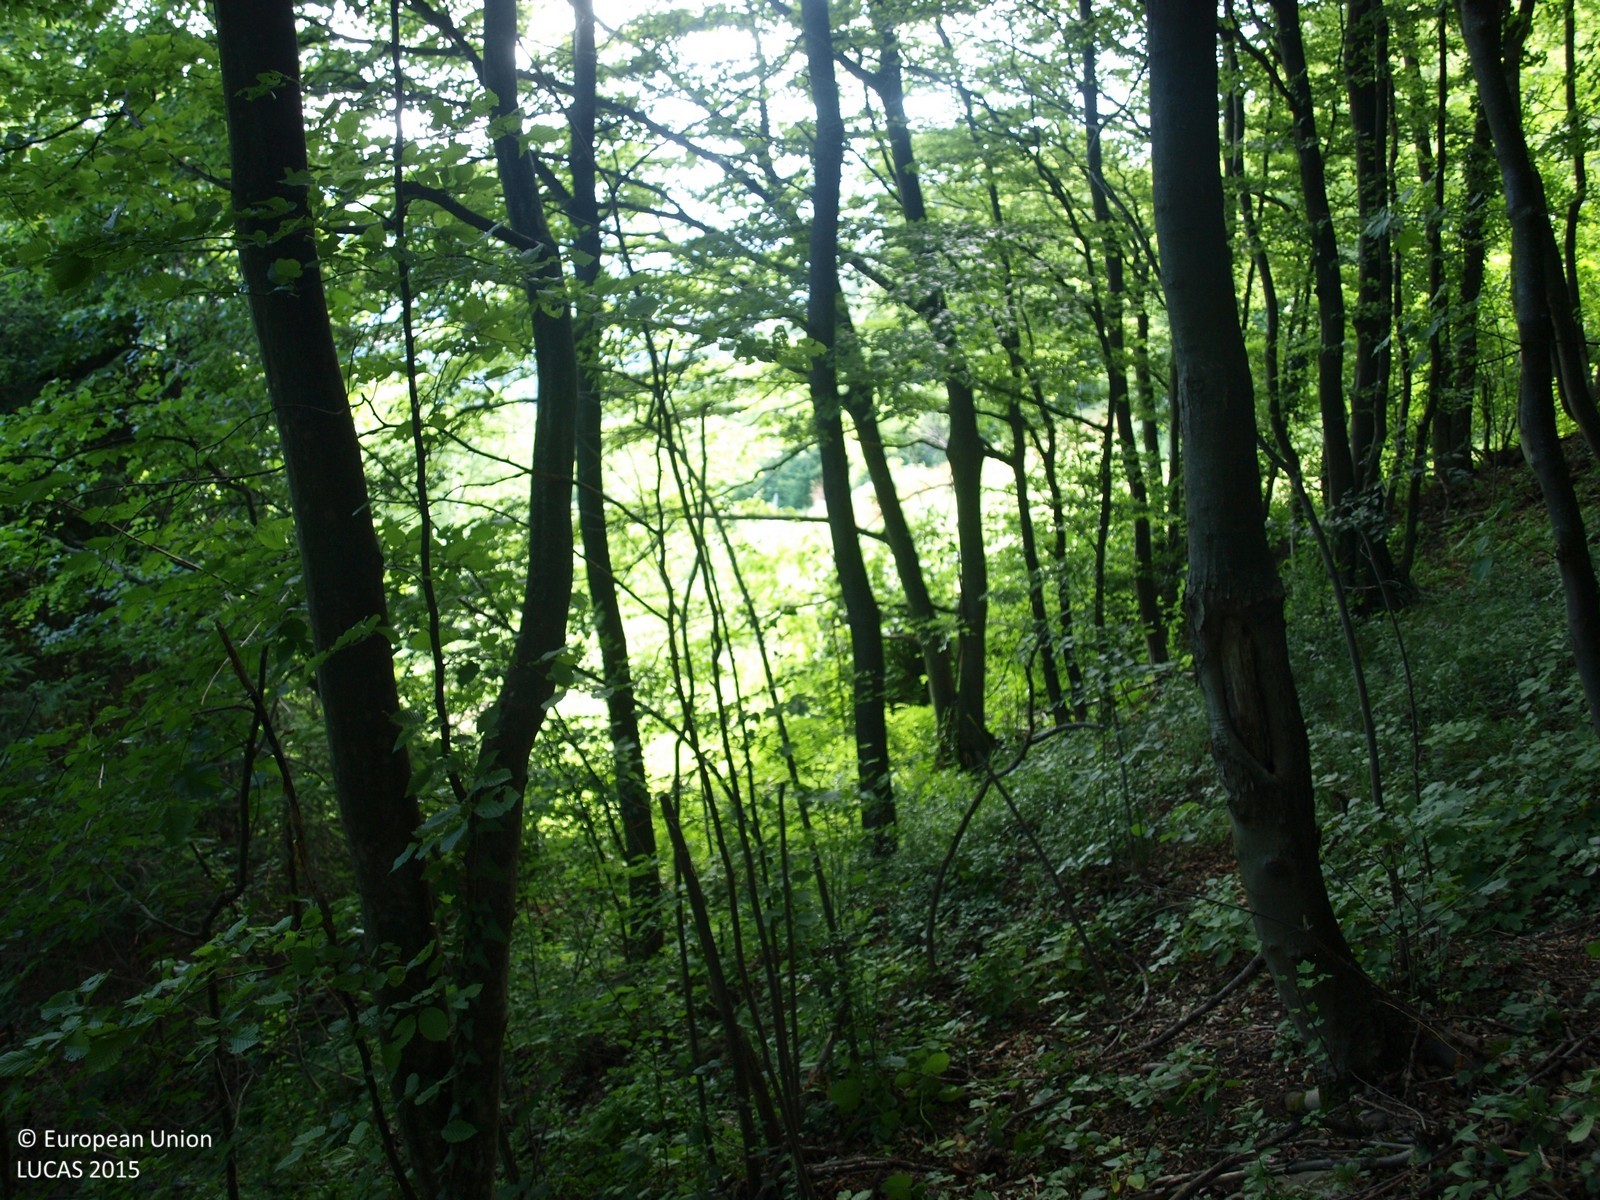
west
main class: Woodland
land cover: Broadleaved woodland
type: mesophytic deciduous forest
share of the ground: > 75 %
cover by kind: broadleaved forest trees 100 %
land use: Forestry
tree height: > 5 m
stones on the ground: < 10 %
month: June
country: HR
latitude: 46.1768
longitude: 16.4121
